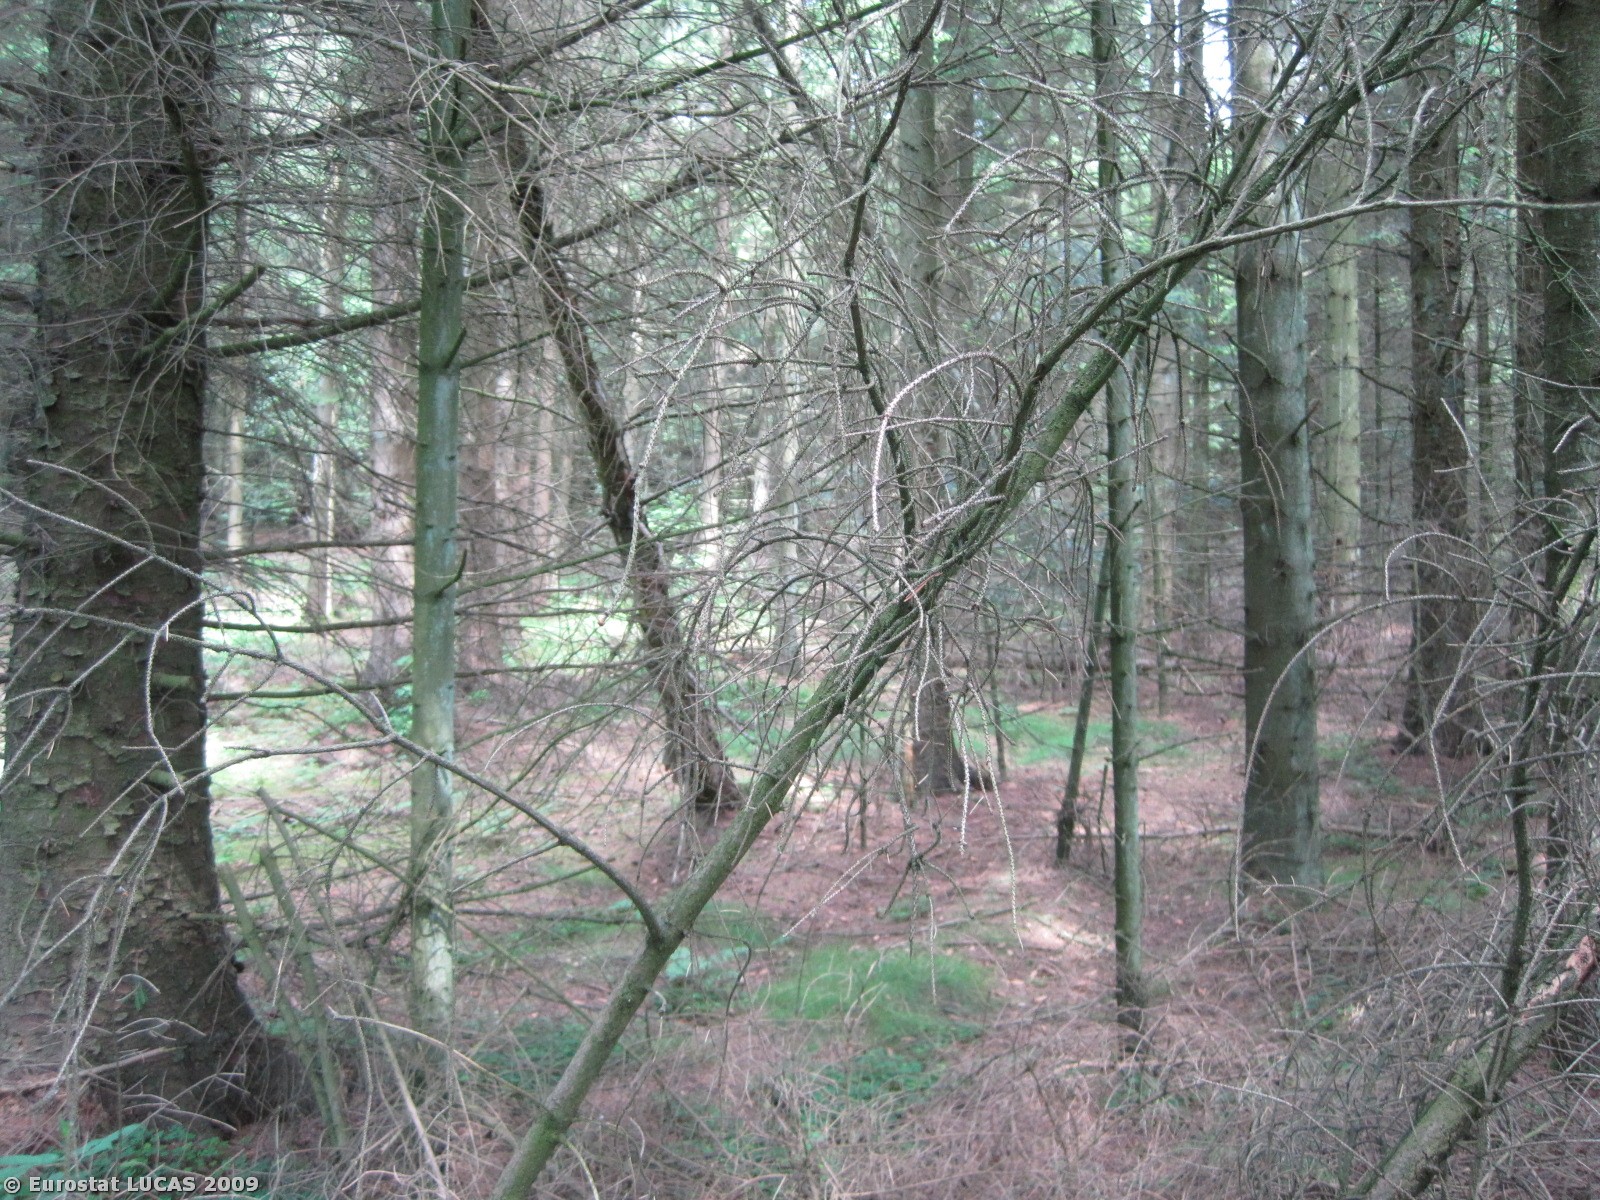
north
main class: Woodland
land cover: Coniferous woodland
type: plantations and self-sown exotic forest
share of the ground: 50 - 75 %
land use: Forestry
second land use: Amenities, museums, leisure
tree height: > 5 m
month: June
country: DK
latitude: 57.1942
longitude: 10.2478
